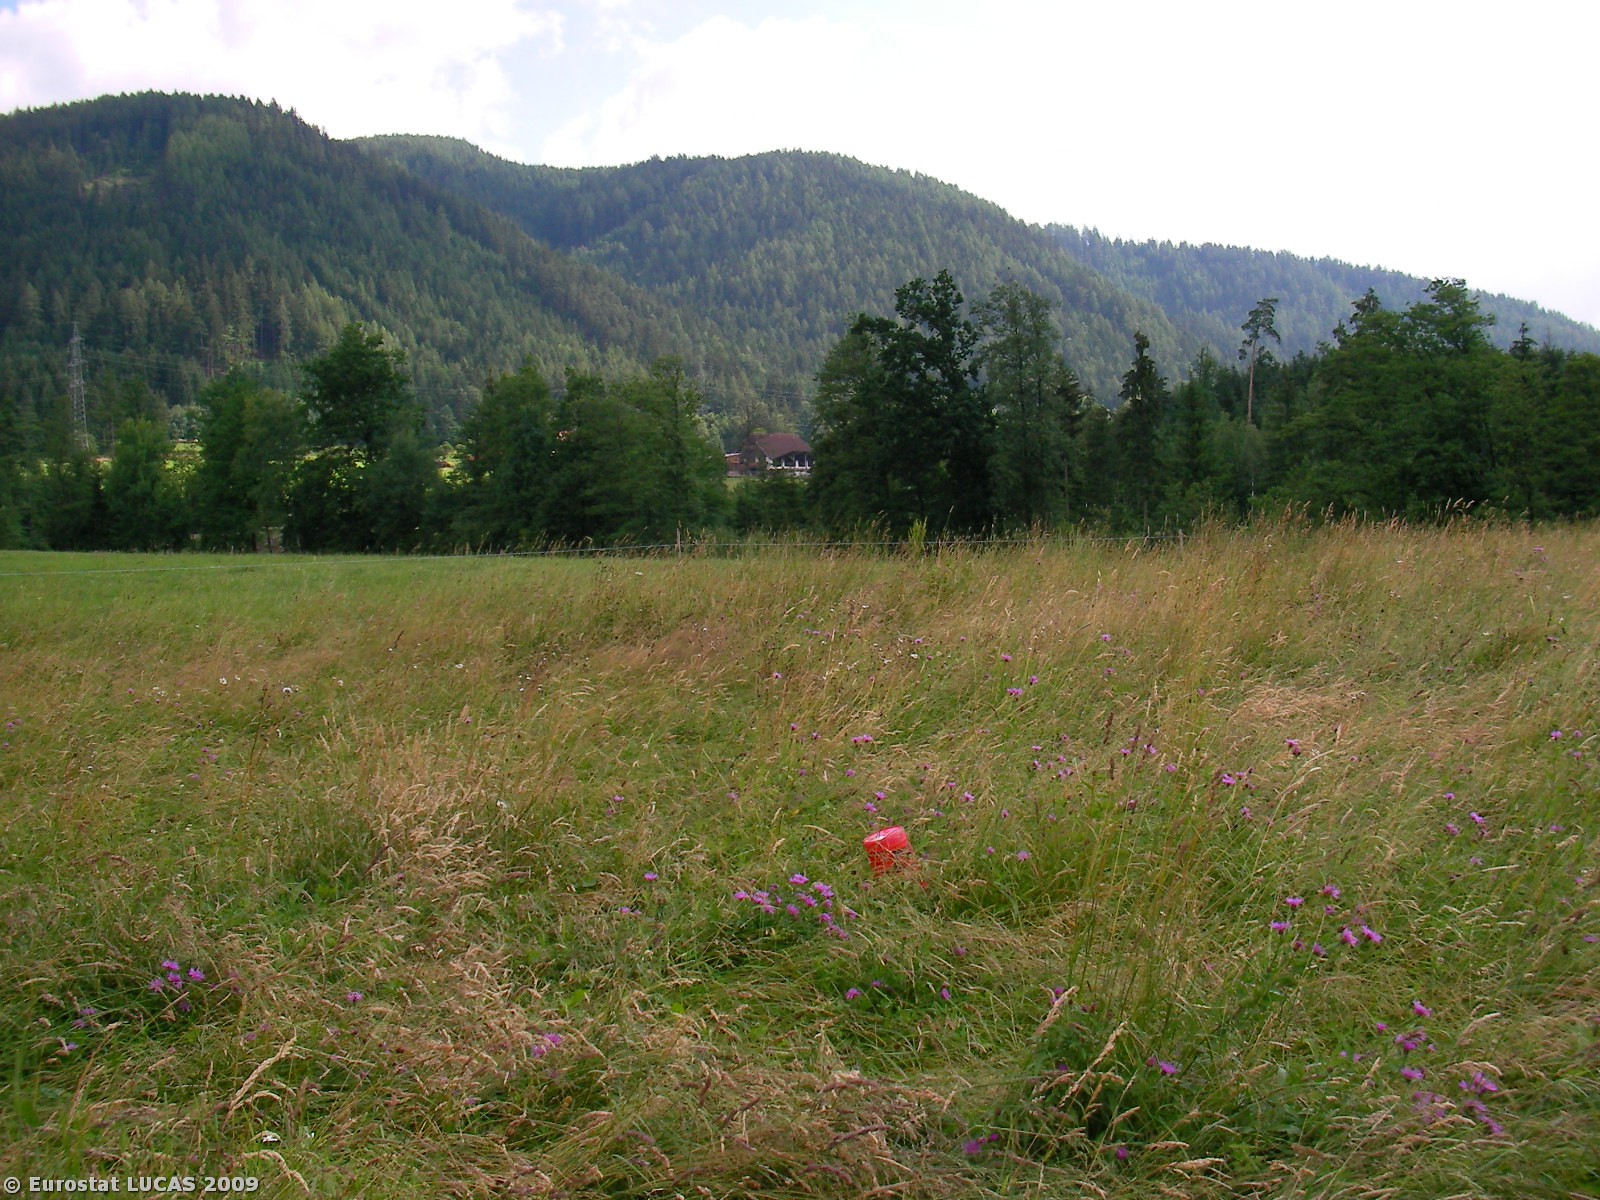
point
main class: Grassland
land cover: Grassland without tree/shrub cover
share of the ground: > 75 %
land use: Agriculture (excluding fallow land and kitchen gardens)
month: June
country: AT
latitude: 47.4805
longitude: 15.3485
